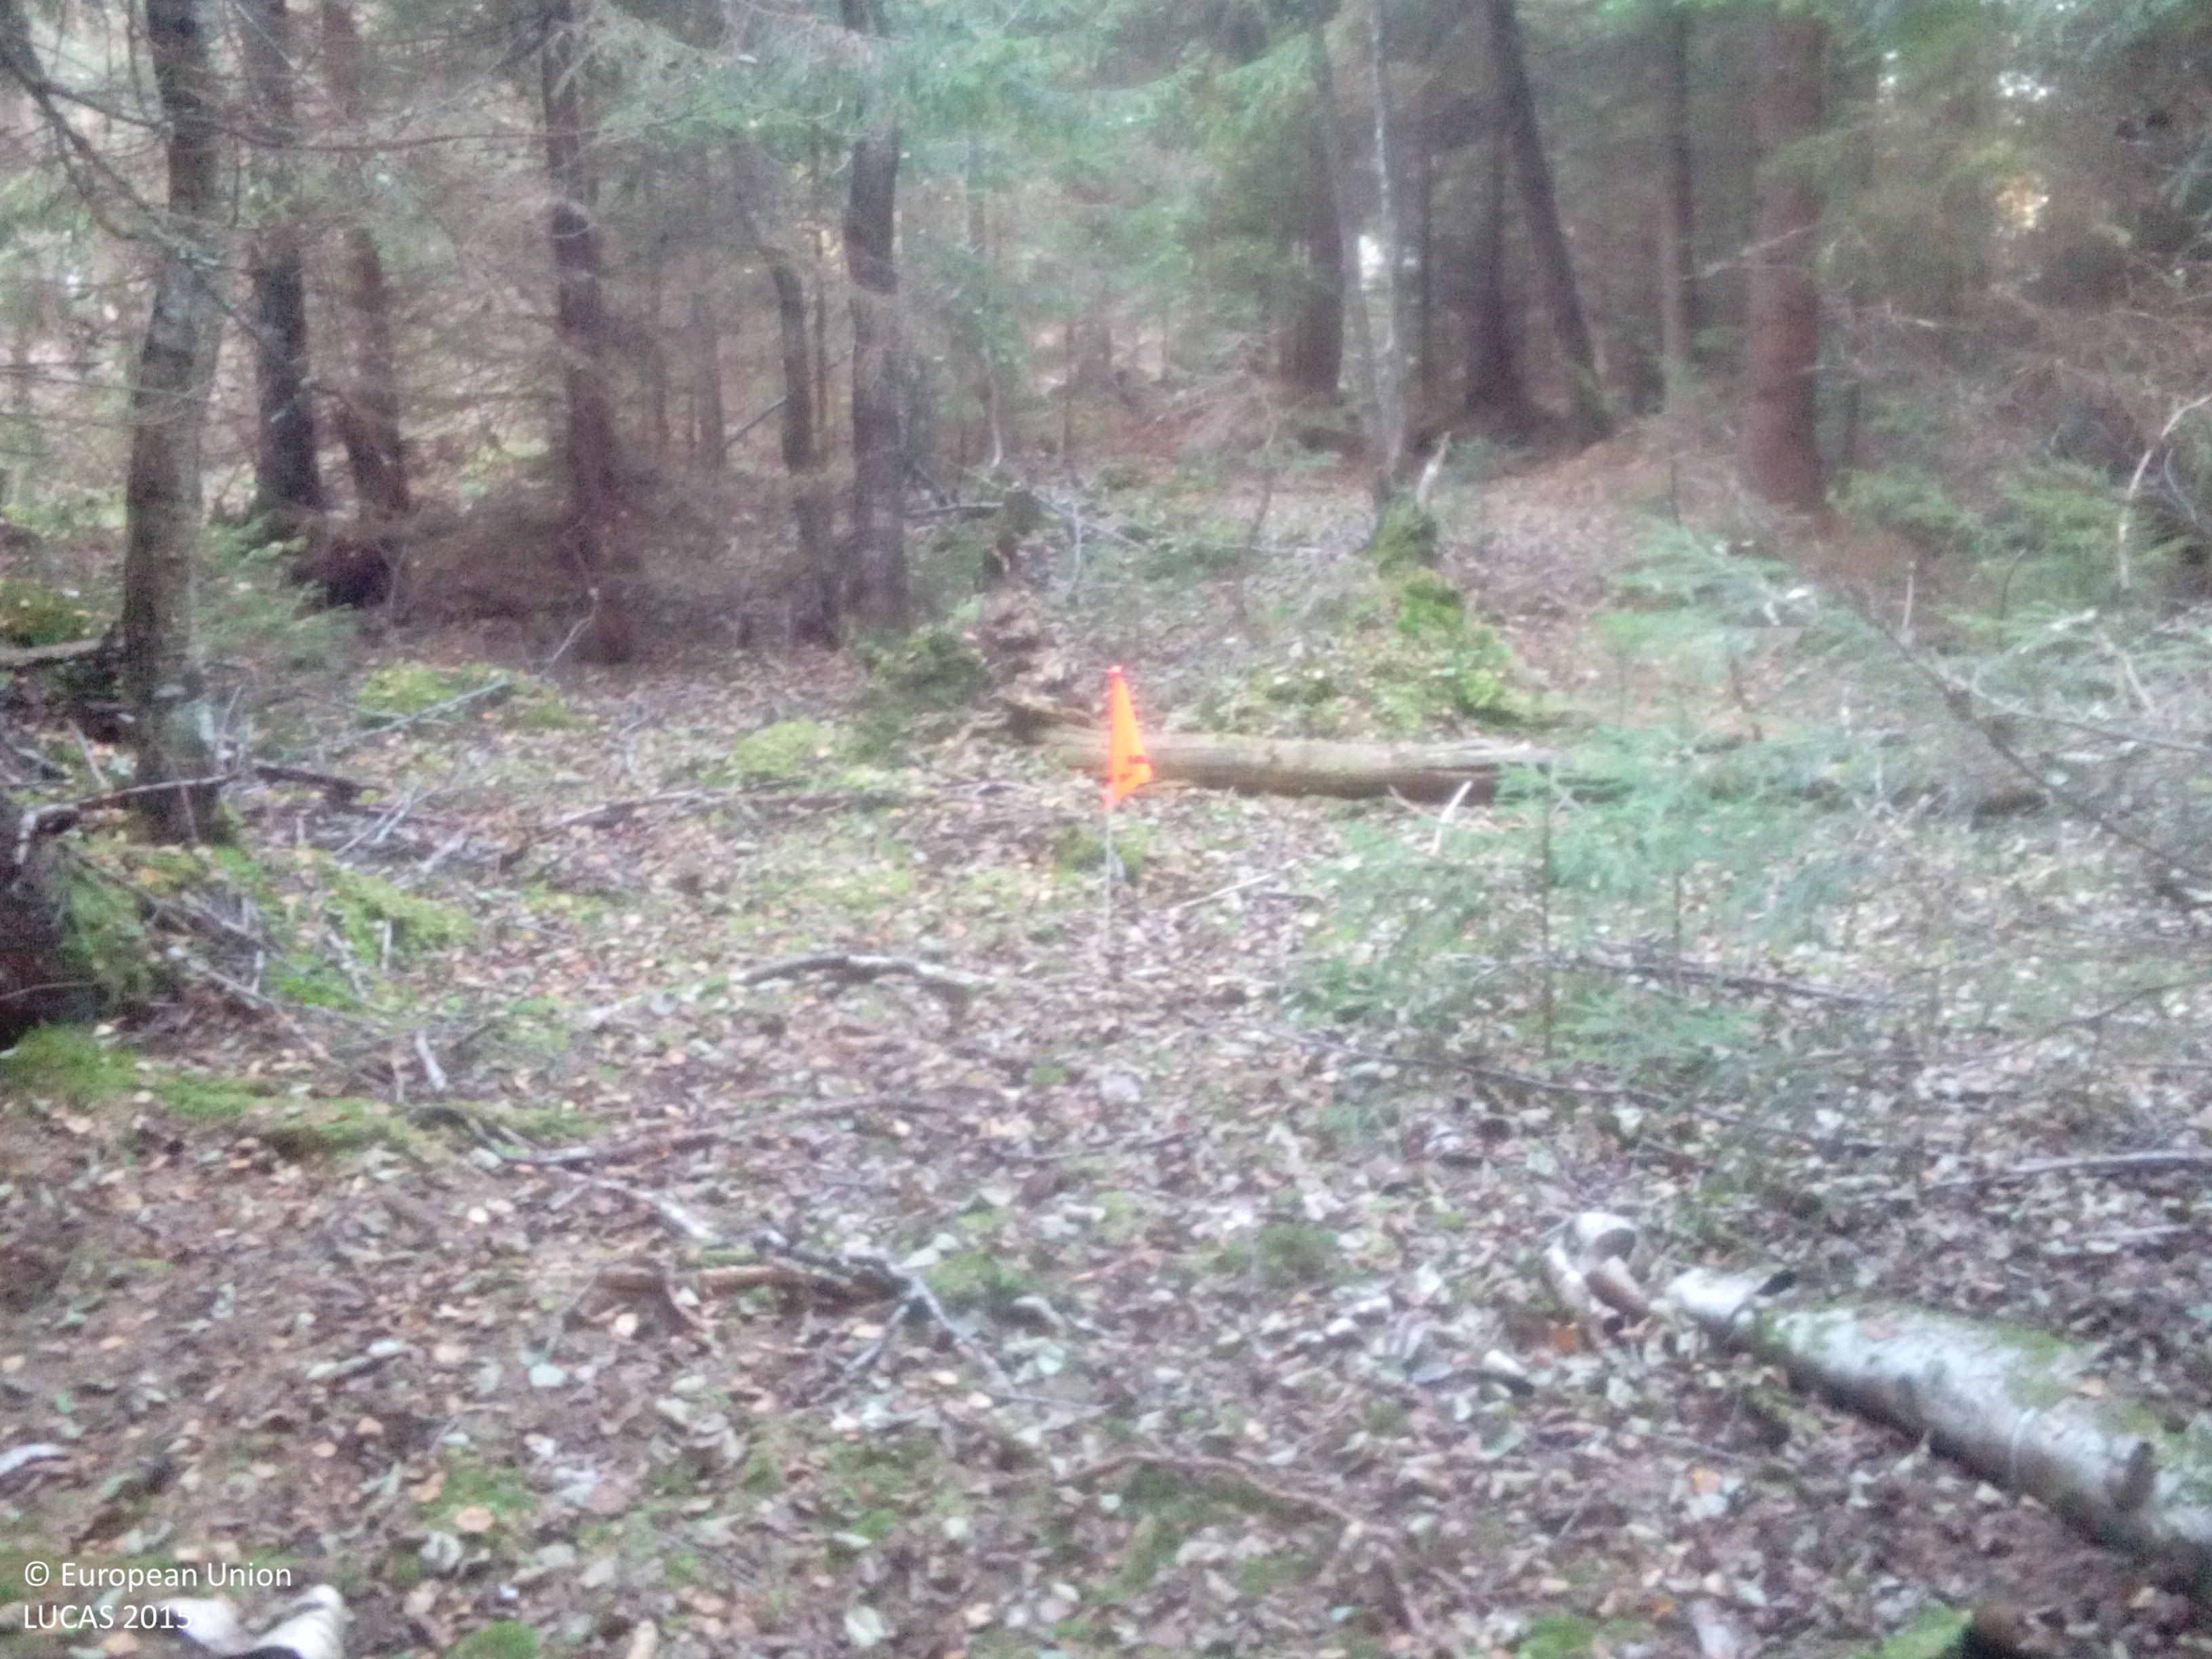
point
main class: Woodland
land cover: Spruce dominated mixed woodland
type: boreal forest
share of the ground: > 75 %
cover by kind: coniferous forest trees 65 %, broadleaved forest trees 30 %, lichens and mosses 5 %
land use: Forestry
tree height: > 5 m
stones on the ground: < 10 %
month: October
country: SE
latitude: 58.9219
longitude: 16.2640
